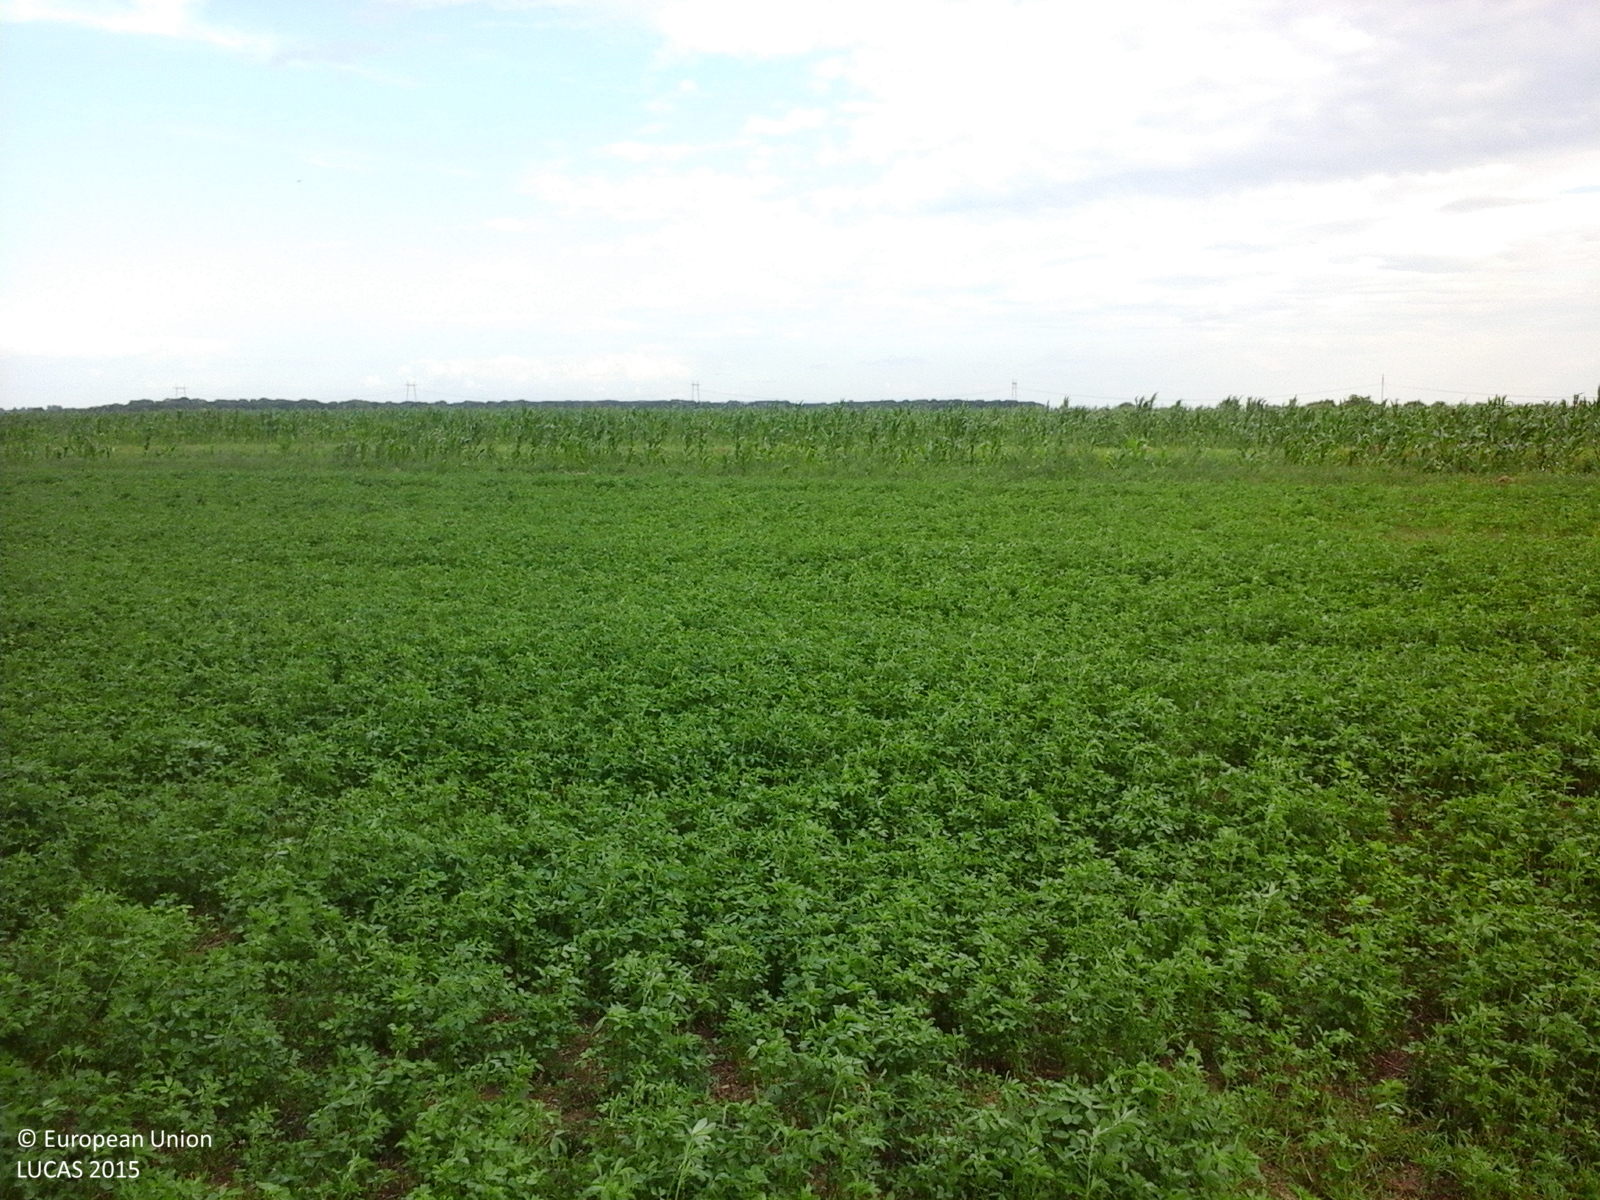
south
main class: Cropland
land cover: Lucerne
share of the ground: > 75 %
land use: Agriculture (excluding fallow land and kitchen gardens)
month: July
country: RO
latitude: 44.2664
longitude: 25.3313
